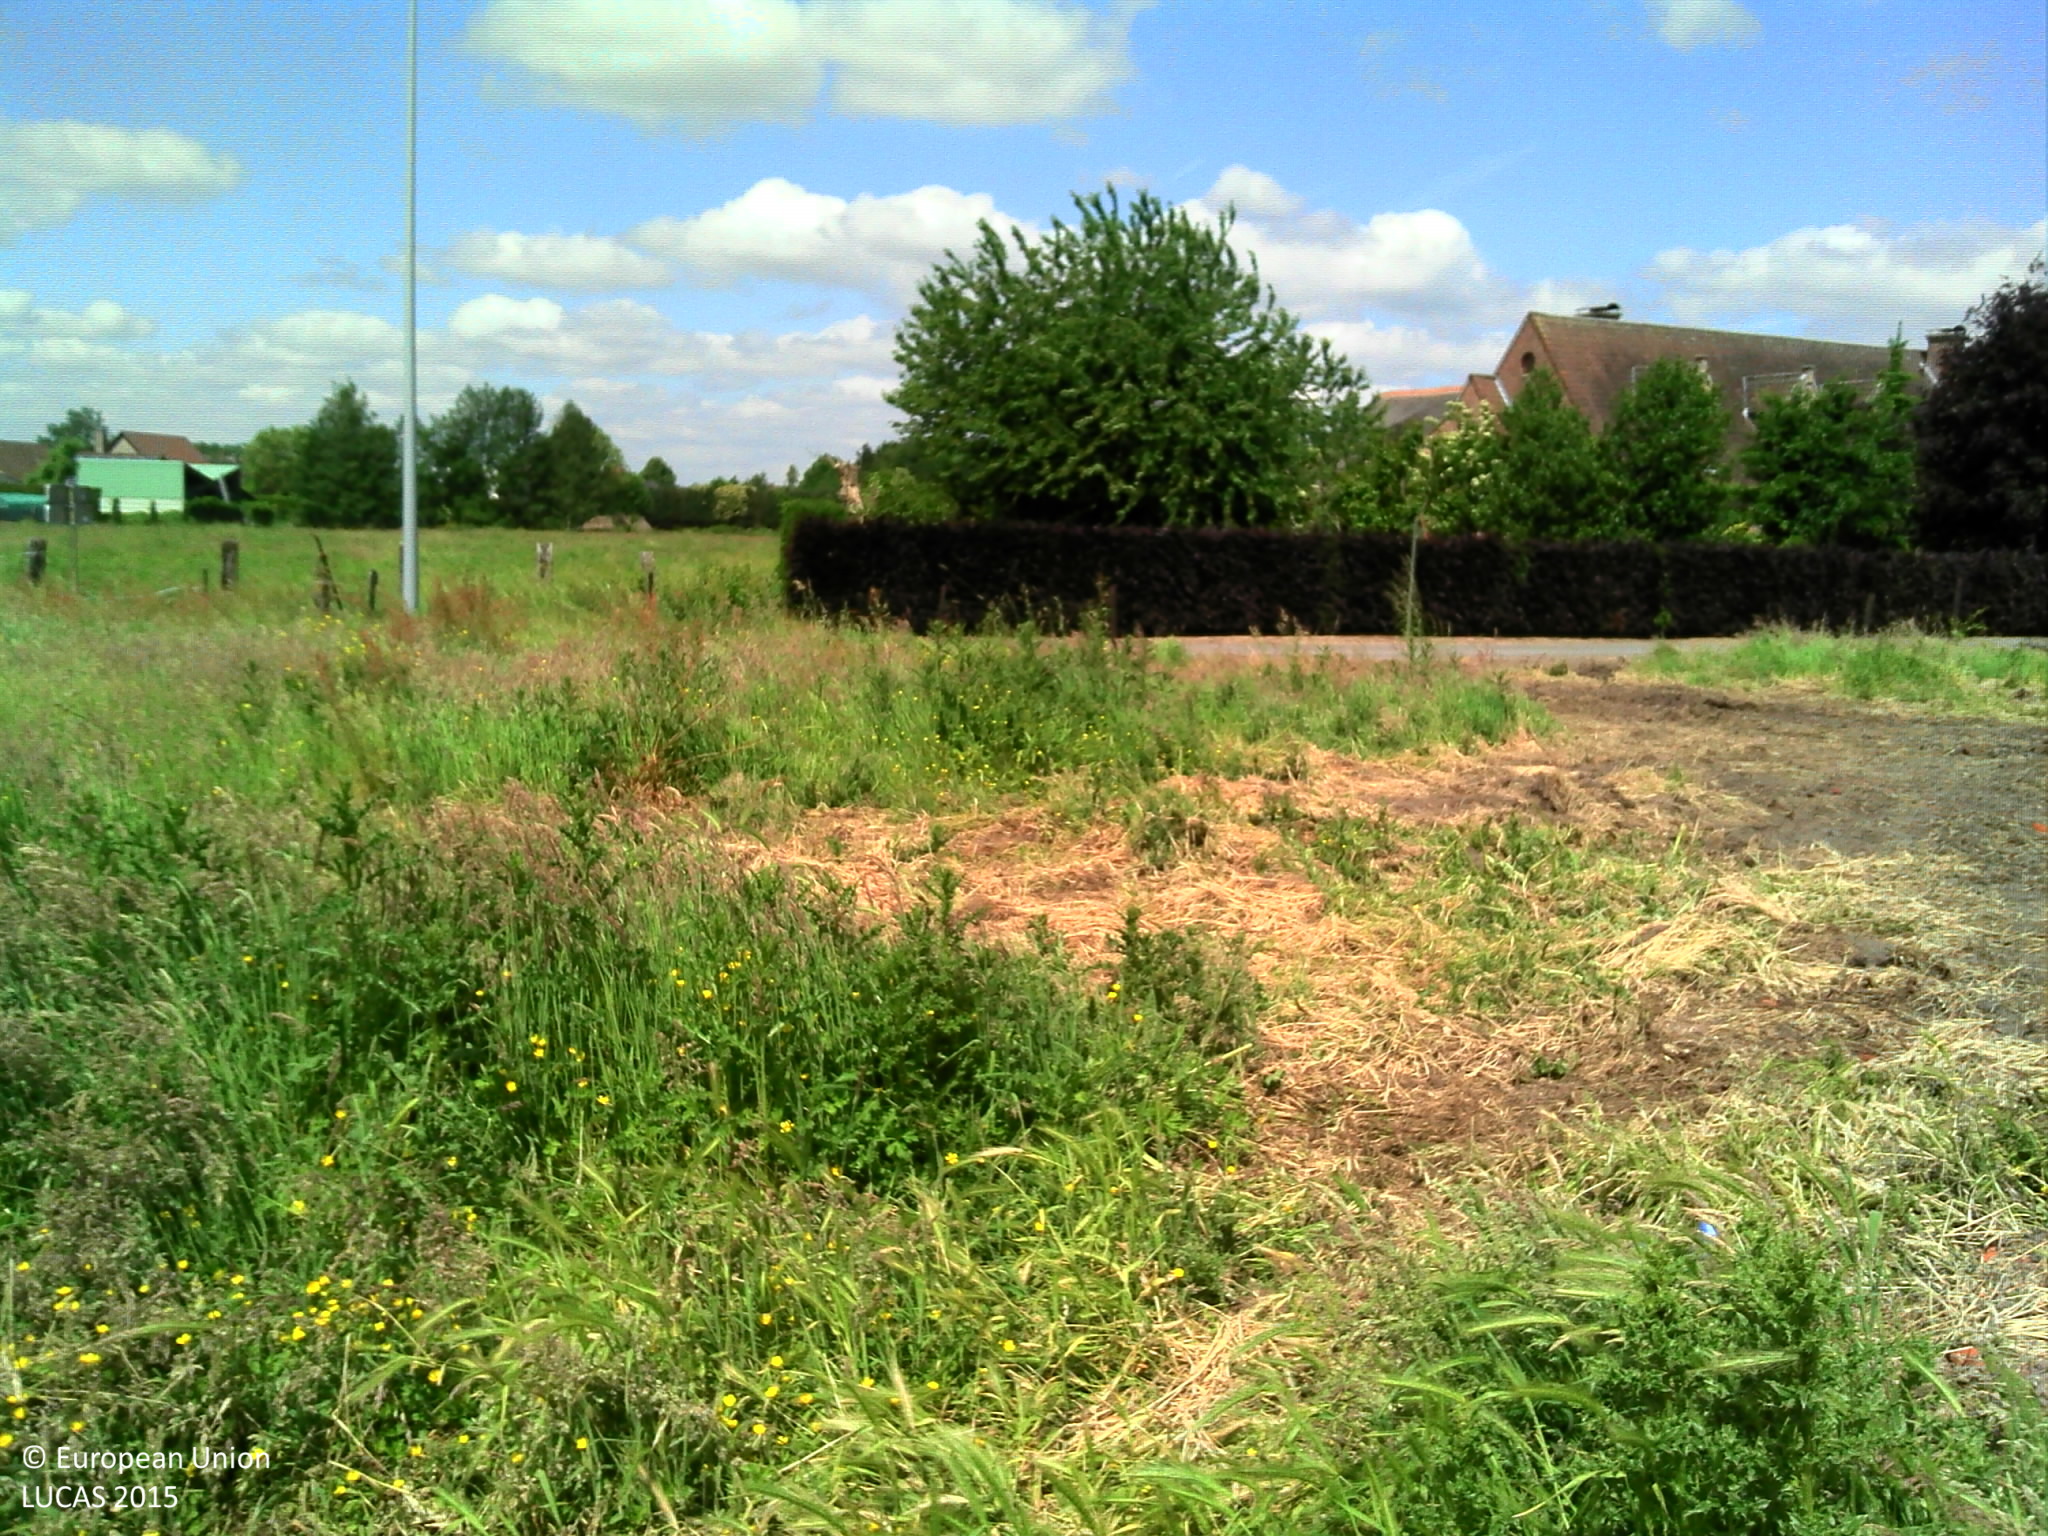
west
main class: Grassland
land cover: Grassland without tree/shrub cover
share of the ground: > 75 %
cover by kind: herbaceous plants 100 %
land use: Residential
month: June
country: BE
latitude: 50.9262
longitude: 3.6332
